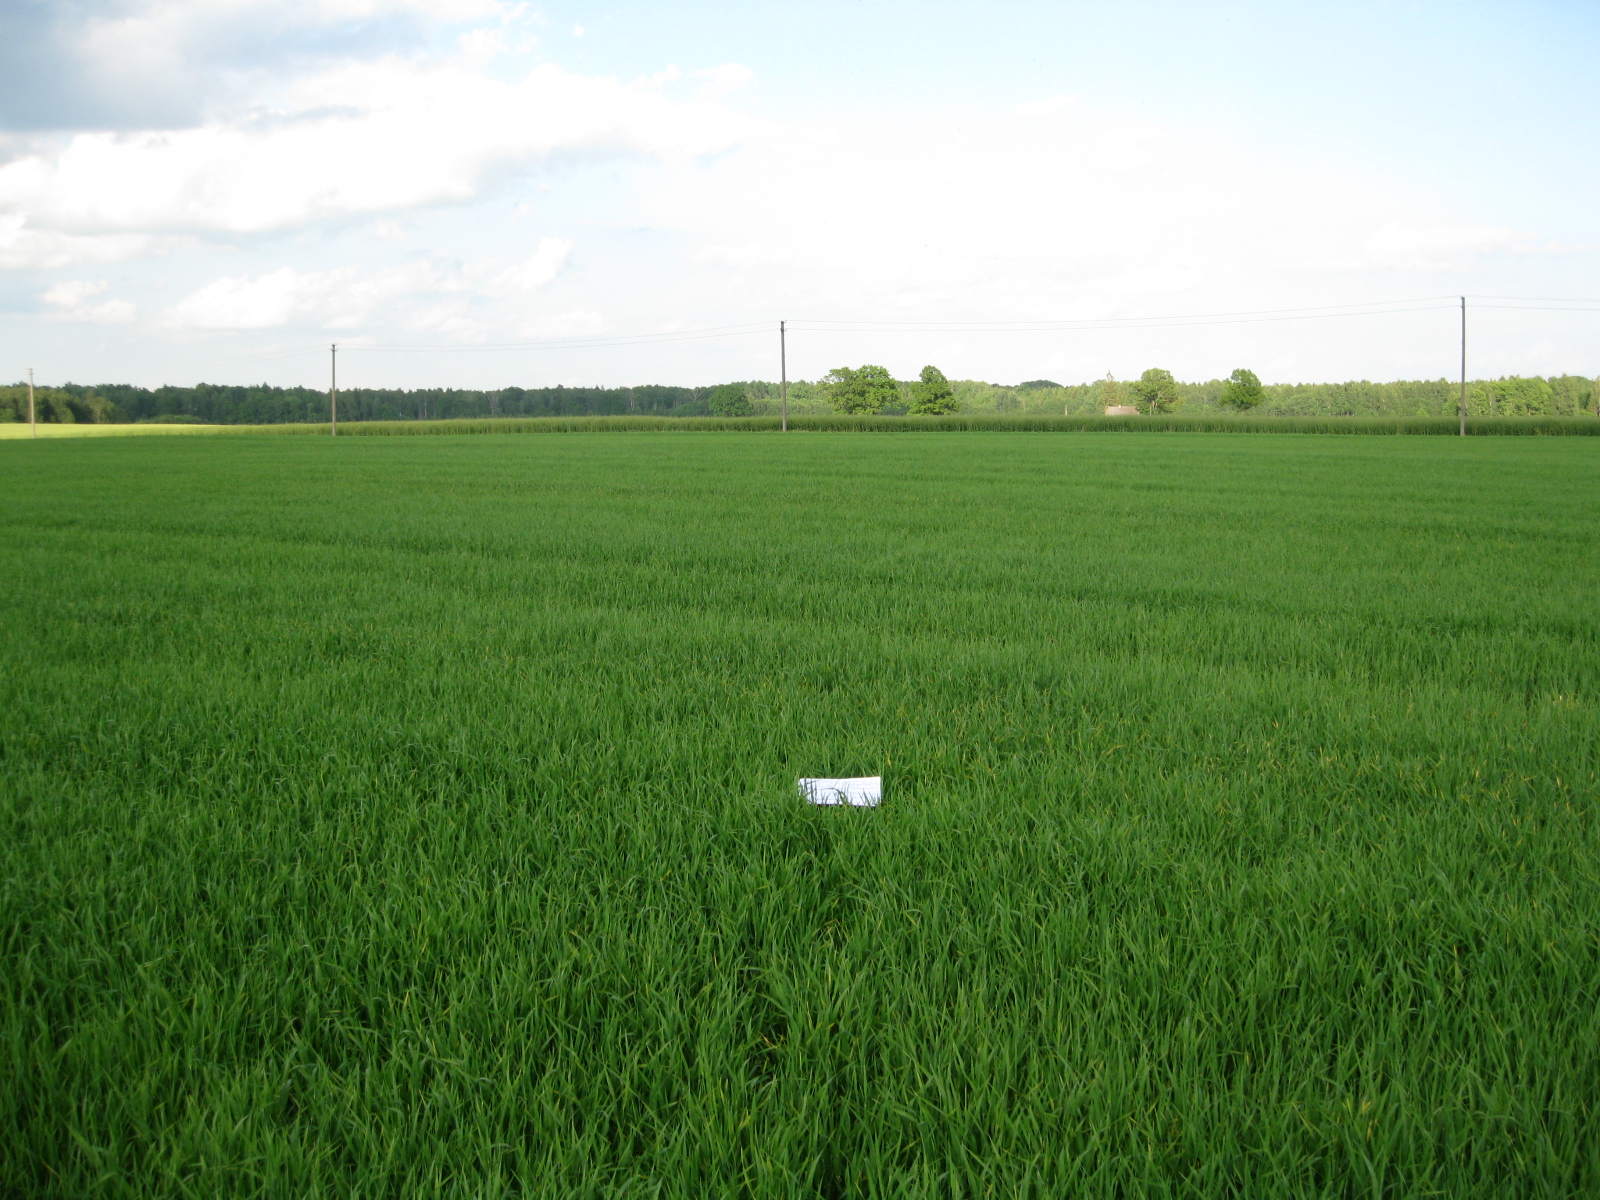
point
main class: Cropland
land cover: Barley
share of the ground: > 75 %
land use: Agriculture (excluding fallow land and kitchen gardens)
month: June
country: LT
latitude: 55.5753
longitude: 23.7075
